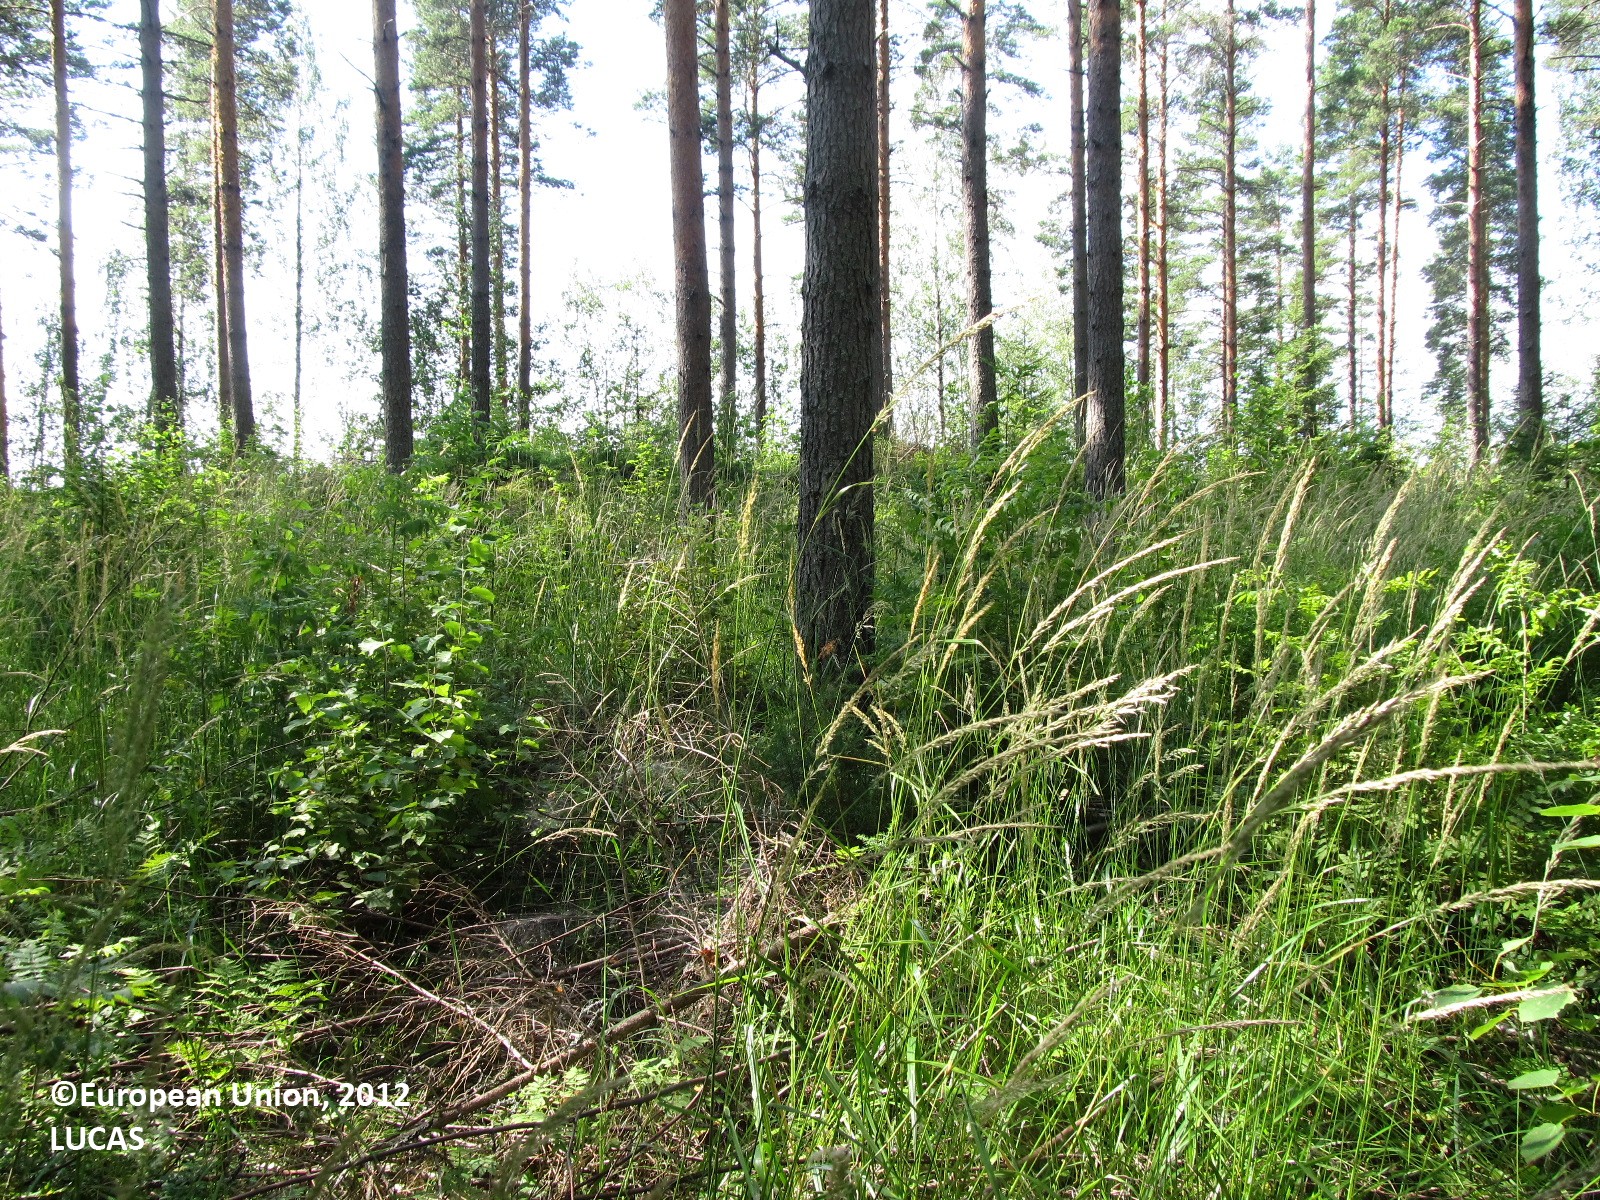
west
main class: Woodland
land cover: Pine dominated mixed woodland
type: boreal forest
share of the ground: 25 - 50 %
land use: Forestry
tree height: > 5 m
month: August
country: FI
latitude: 62.0943
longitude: 28.6955
